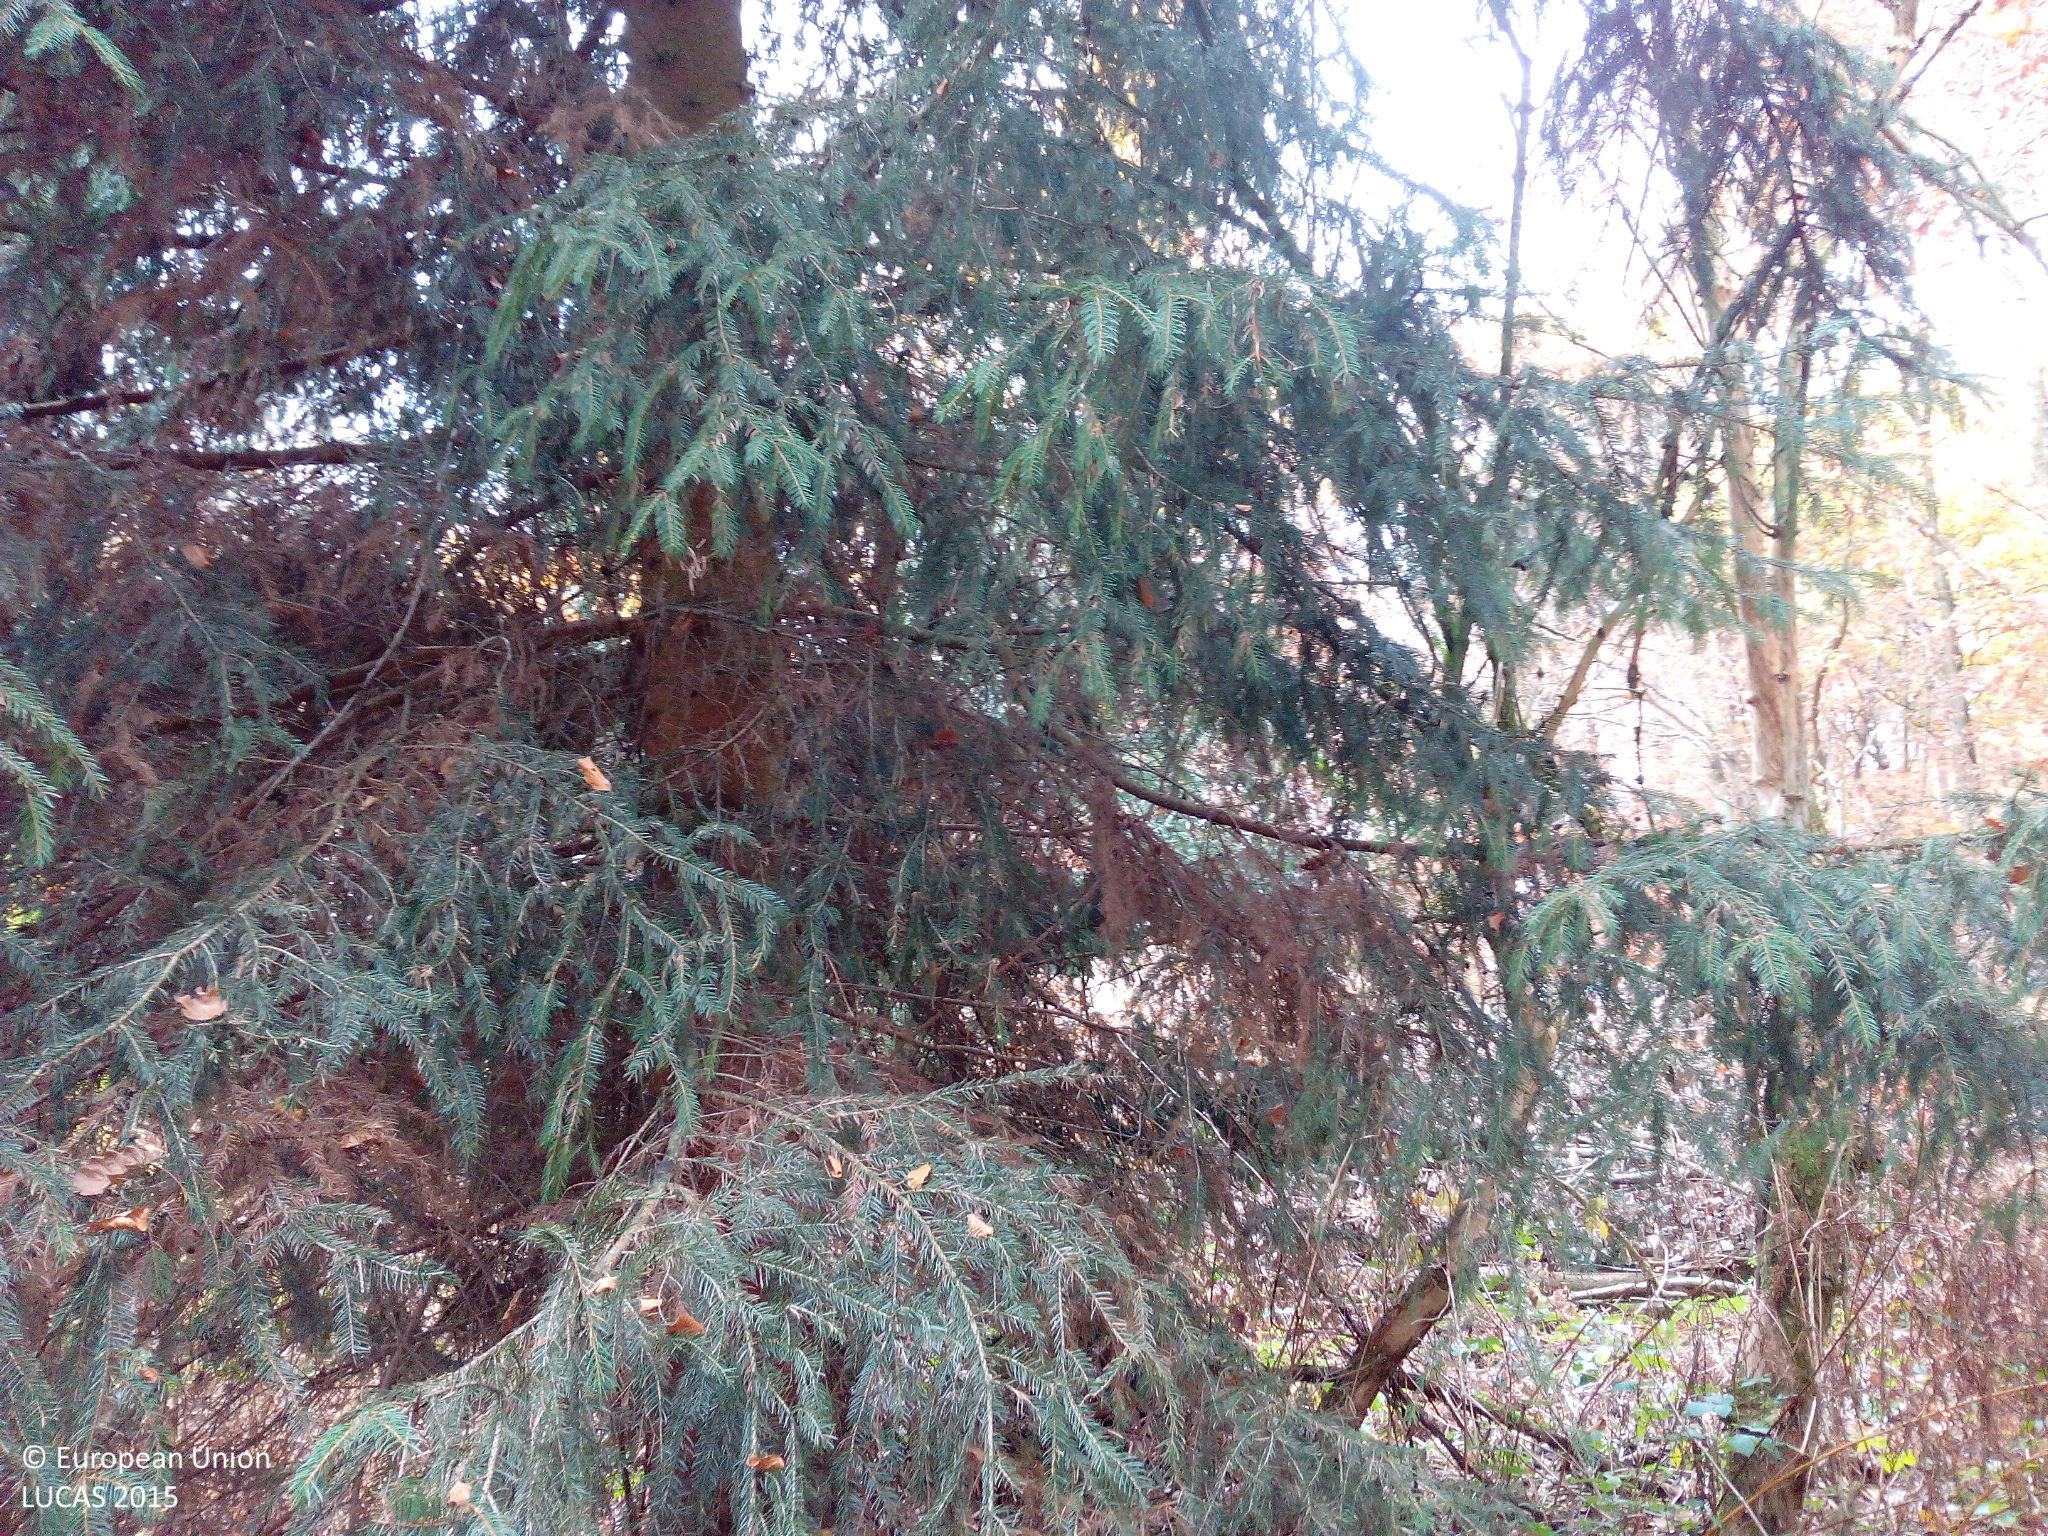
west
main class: Woodland
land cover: Spruce dominated mixed woodland
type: hemiboreal forest and nemoral coniferous forest and mixed broadleaved-coniferous forest
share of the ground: > 75 %
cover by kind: broadleaved forest trees 40 %, coniferous forest trees 35 %, shrubs 20 %, herbaceous plants 5 %
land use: Forestry
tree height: > 5 m
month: November
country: DE
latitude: 48.8336
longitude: 9.3872
